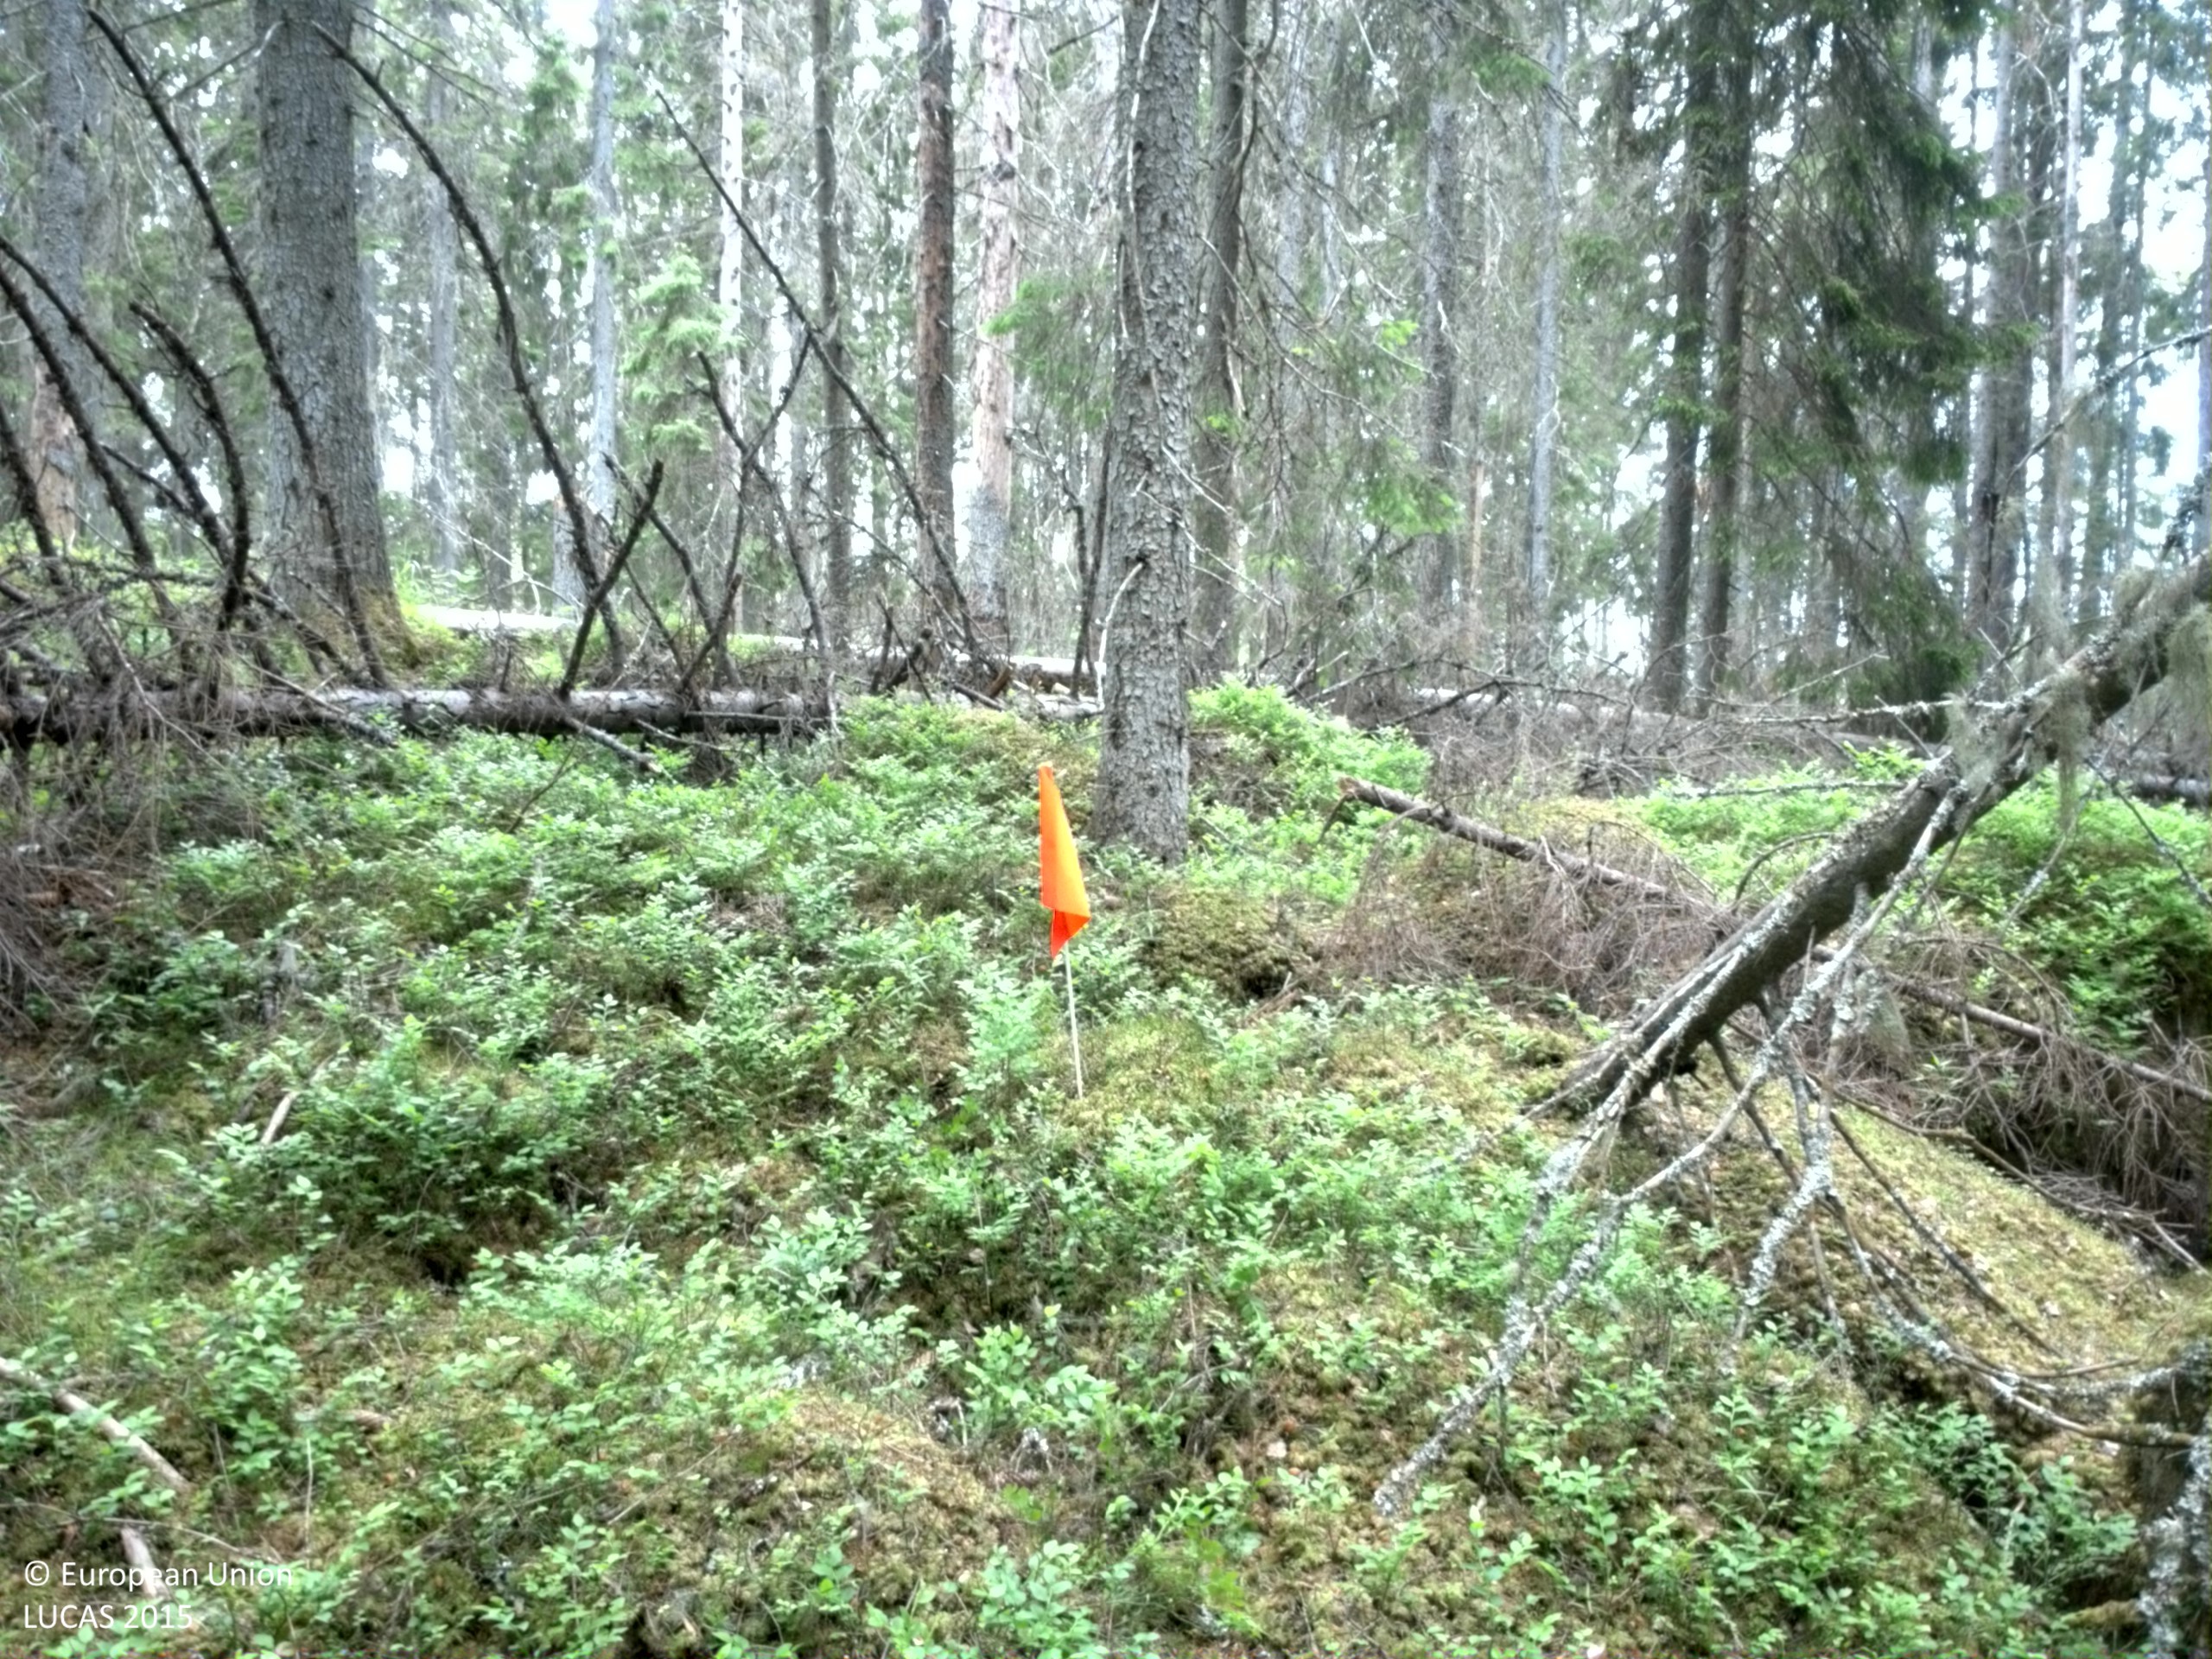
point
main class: Woodland
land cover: Spruce dominated coniferous woodland
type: boreal forest
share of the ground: > 75 %
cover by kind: coniferous forest trees 75 %, shrubs 10 %, lichens and mosses 10 %, broadleaved forest trees 5 %
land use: Forestry
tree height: > 5 m
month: June
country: SE
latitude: 60.3109
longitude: 17.7577
